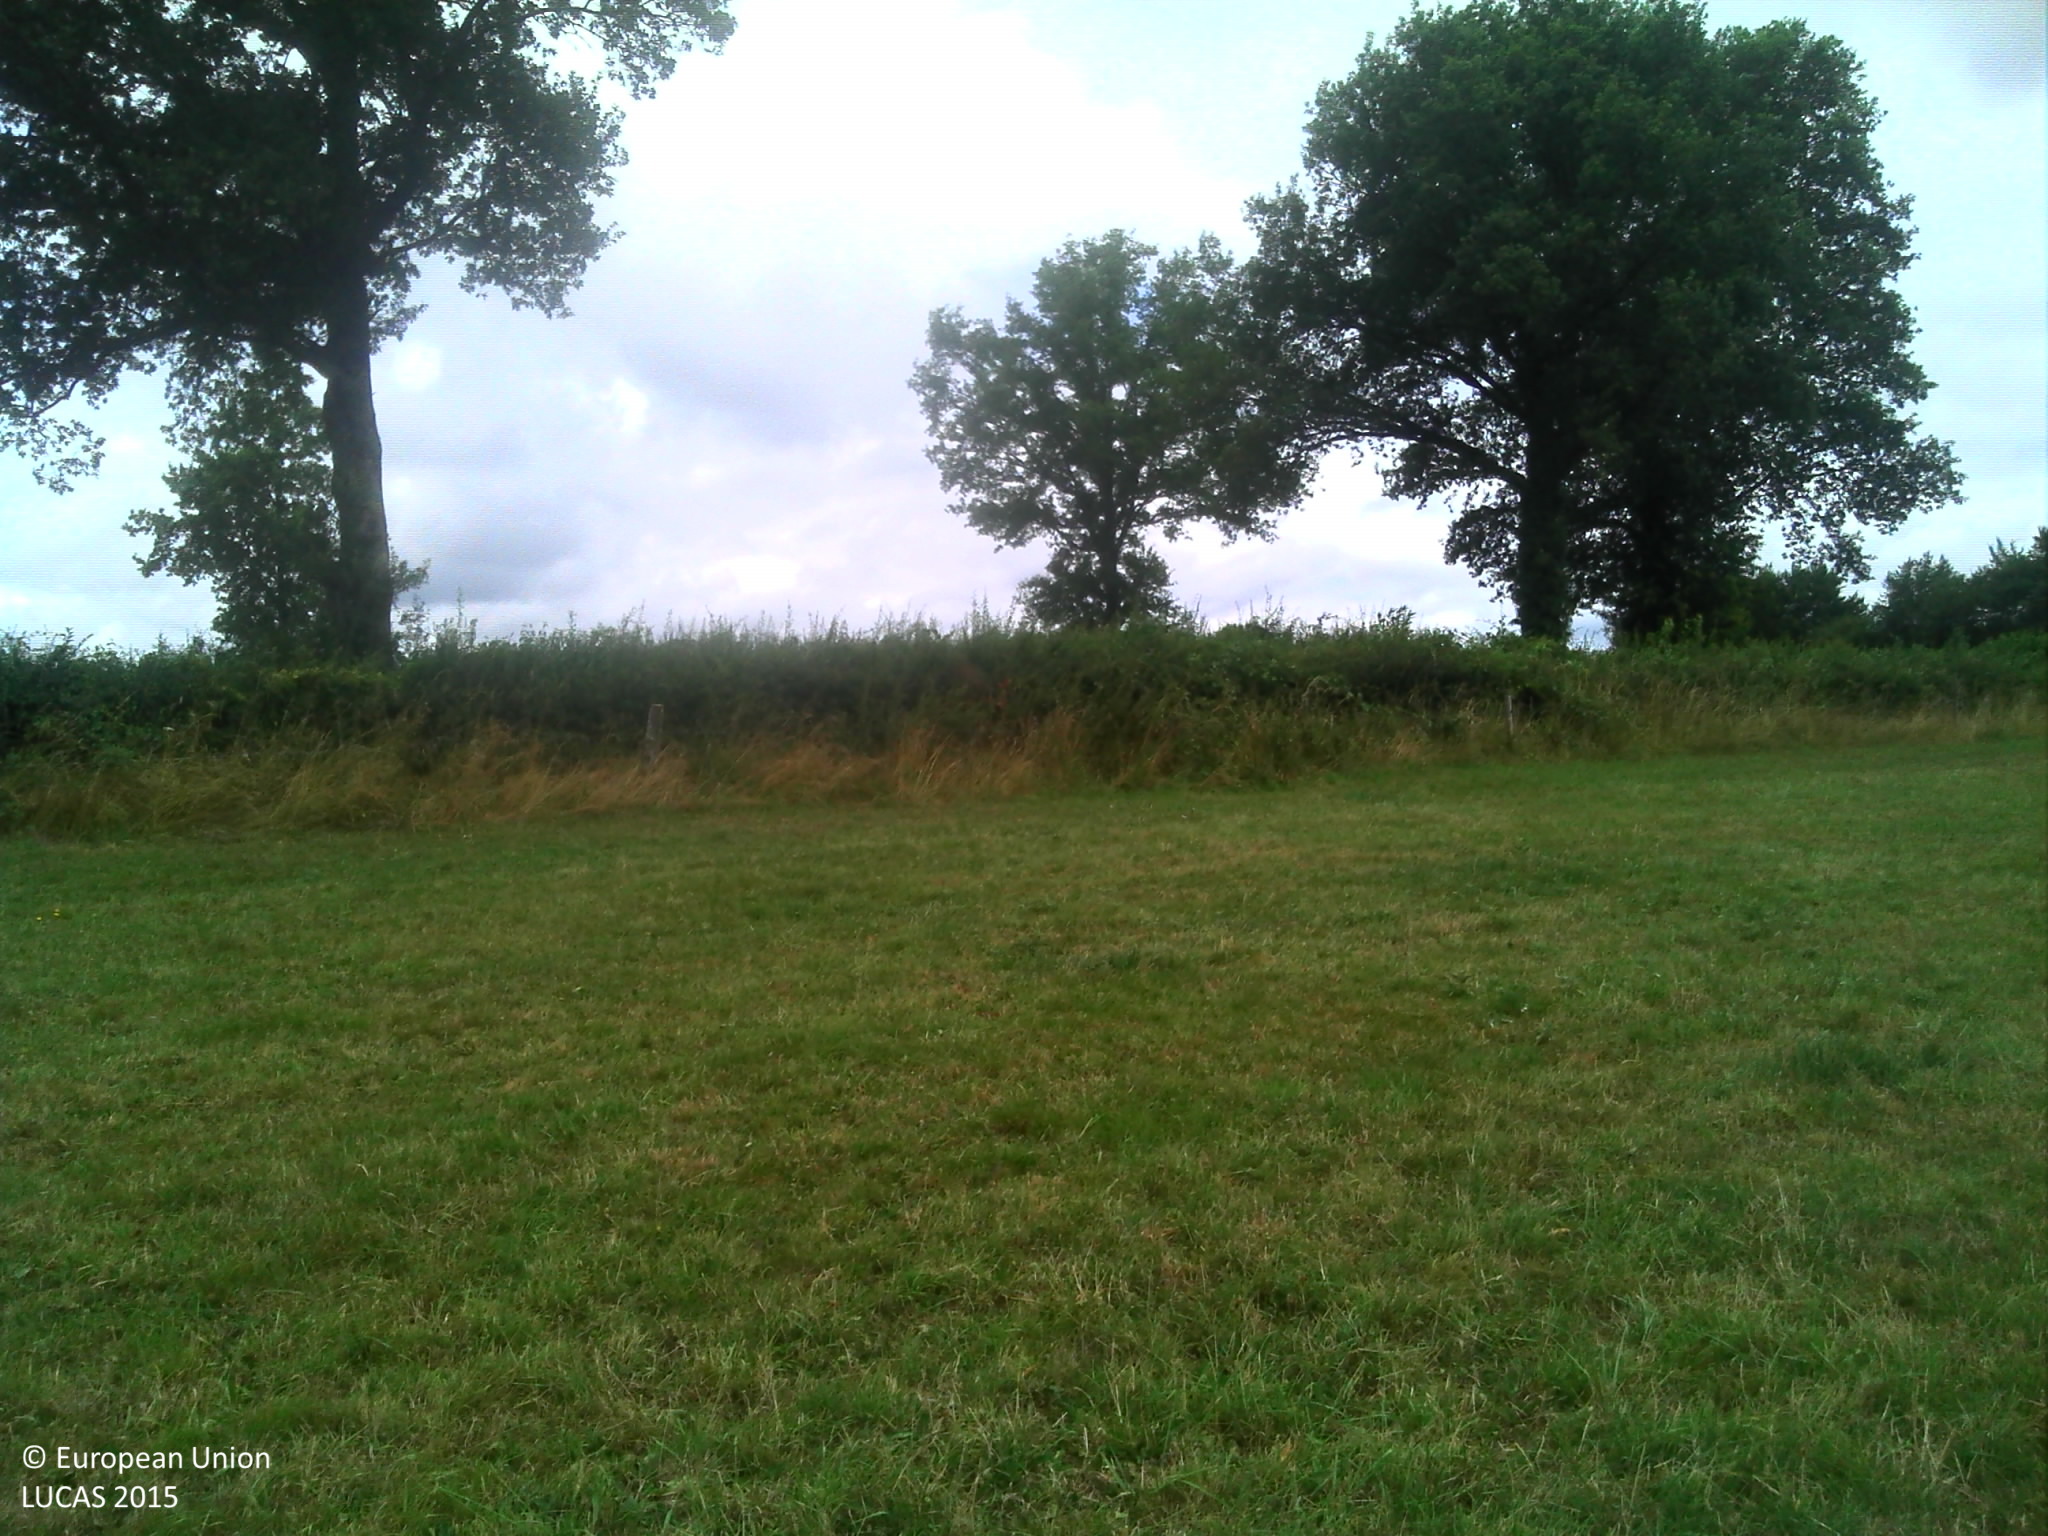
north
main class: Grassland
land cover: Grassland without tree/shrub cover
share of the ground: > 75 %
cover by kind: herbaceous plants 100 %
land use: Agriculture (excluding fallow land and kitchen gardens)
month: July
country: FR
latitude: 46.3766
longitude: 1.5267
